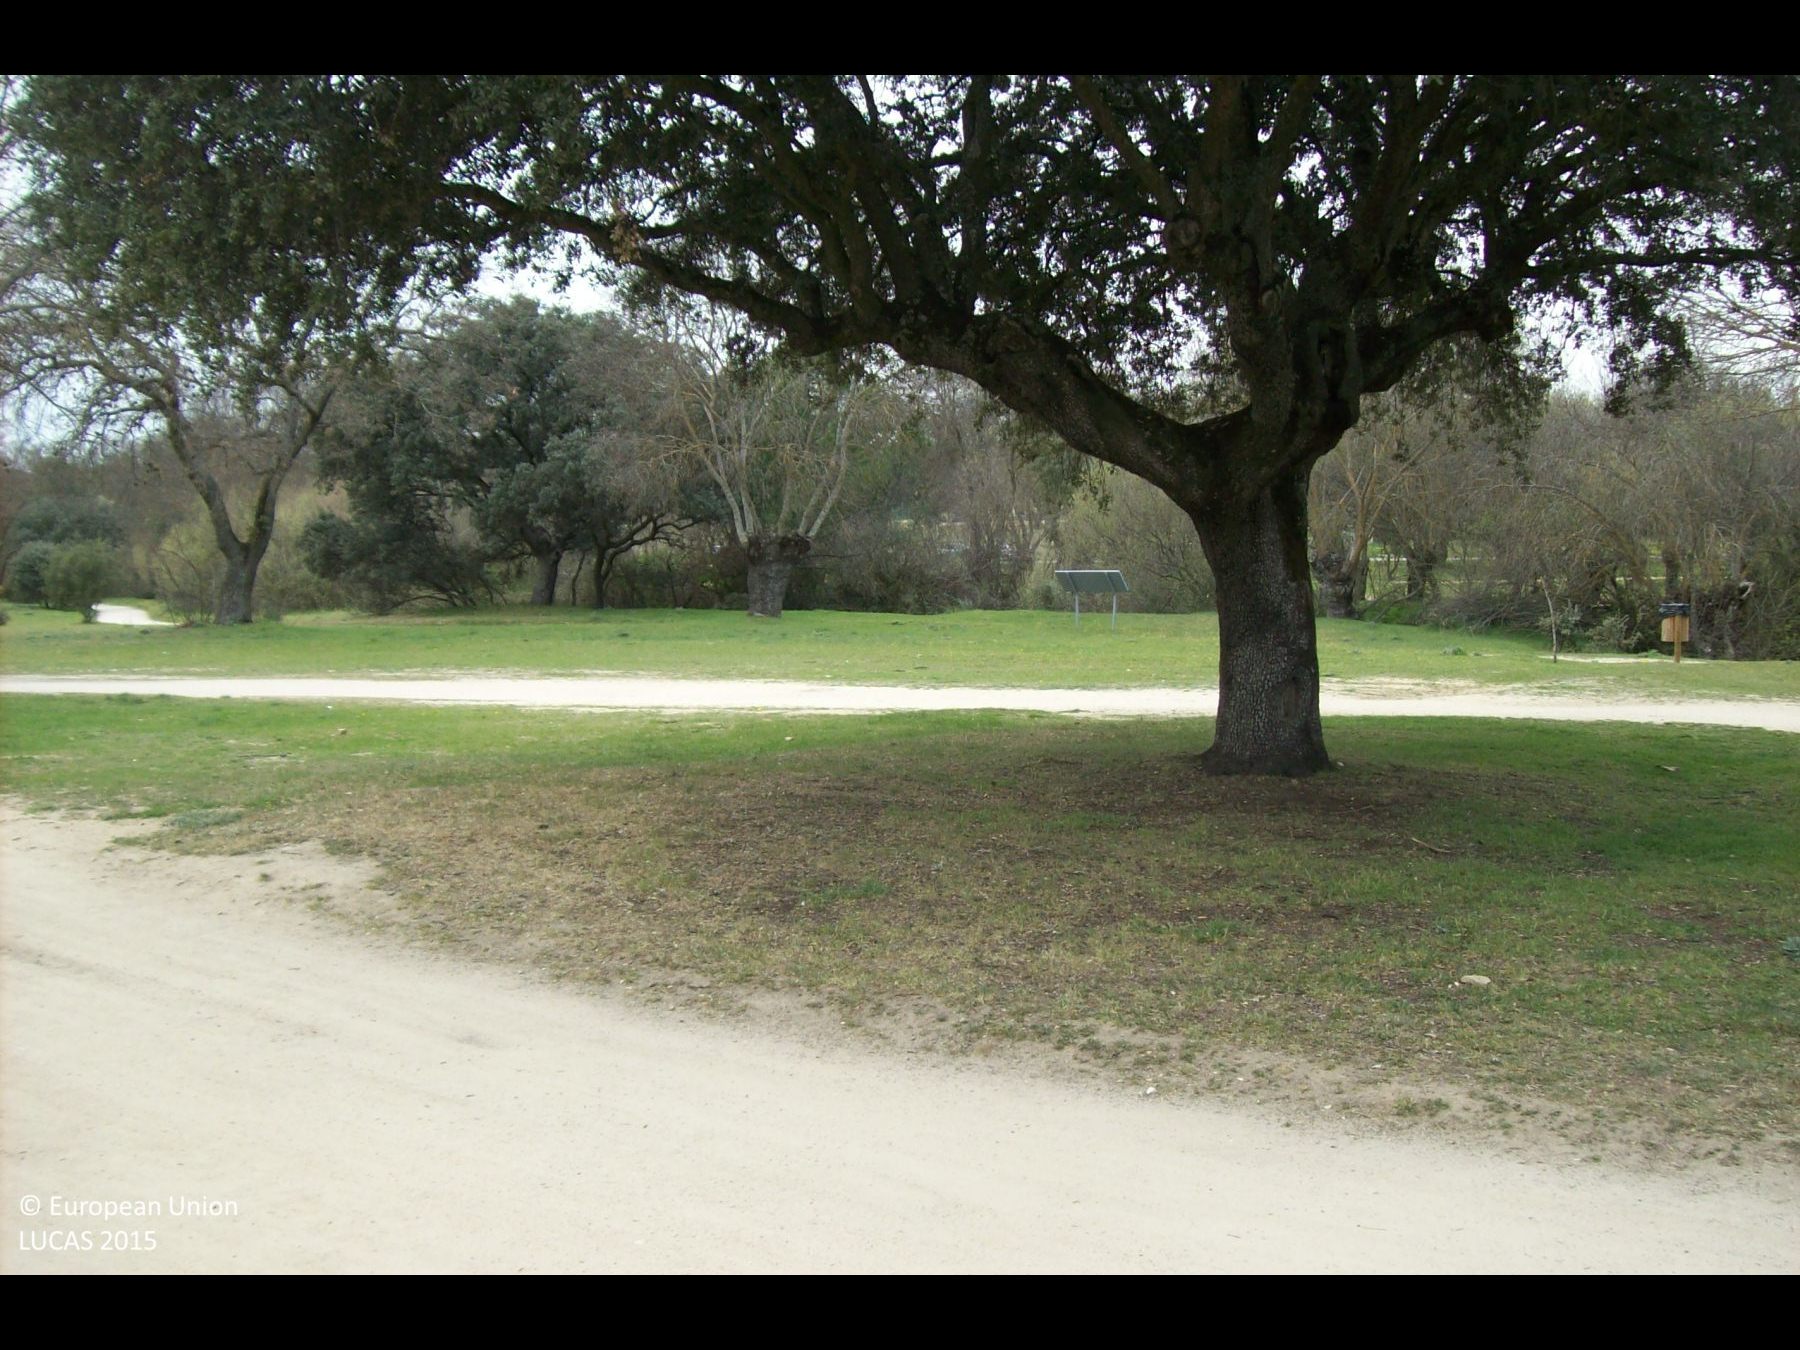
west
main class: Woodland
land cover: Broadleaved woodland
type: thermophilous deciduous forest
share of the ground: 25 - 50 %
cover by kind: broadleaved forest trees 45 %, herbaceous plants 45 %
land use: Amenities, museums, leisure
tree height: > 5 m
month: April
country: ES
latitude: 40.4139
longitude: -3.8632
